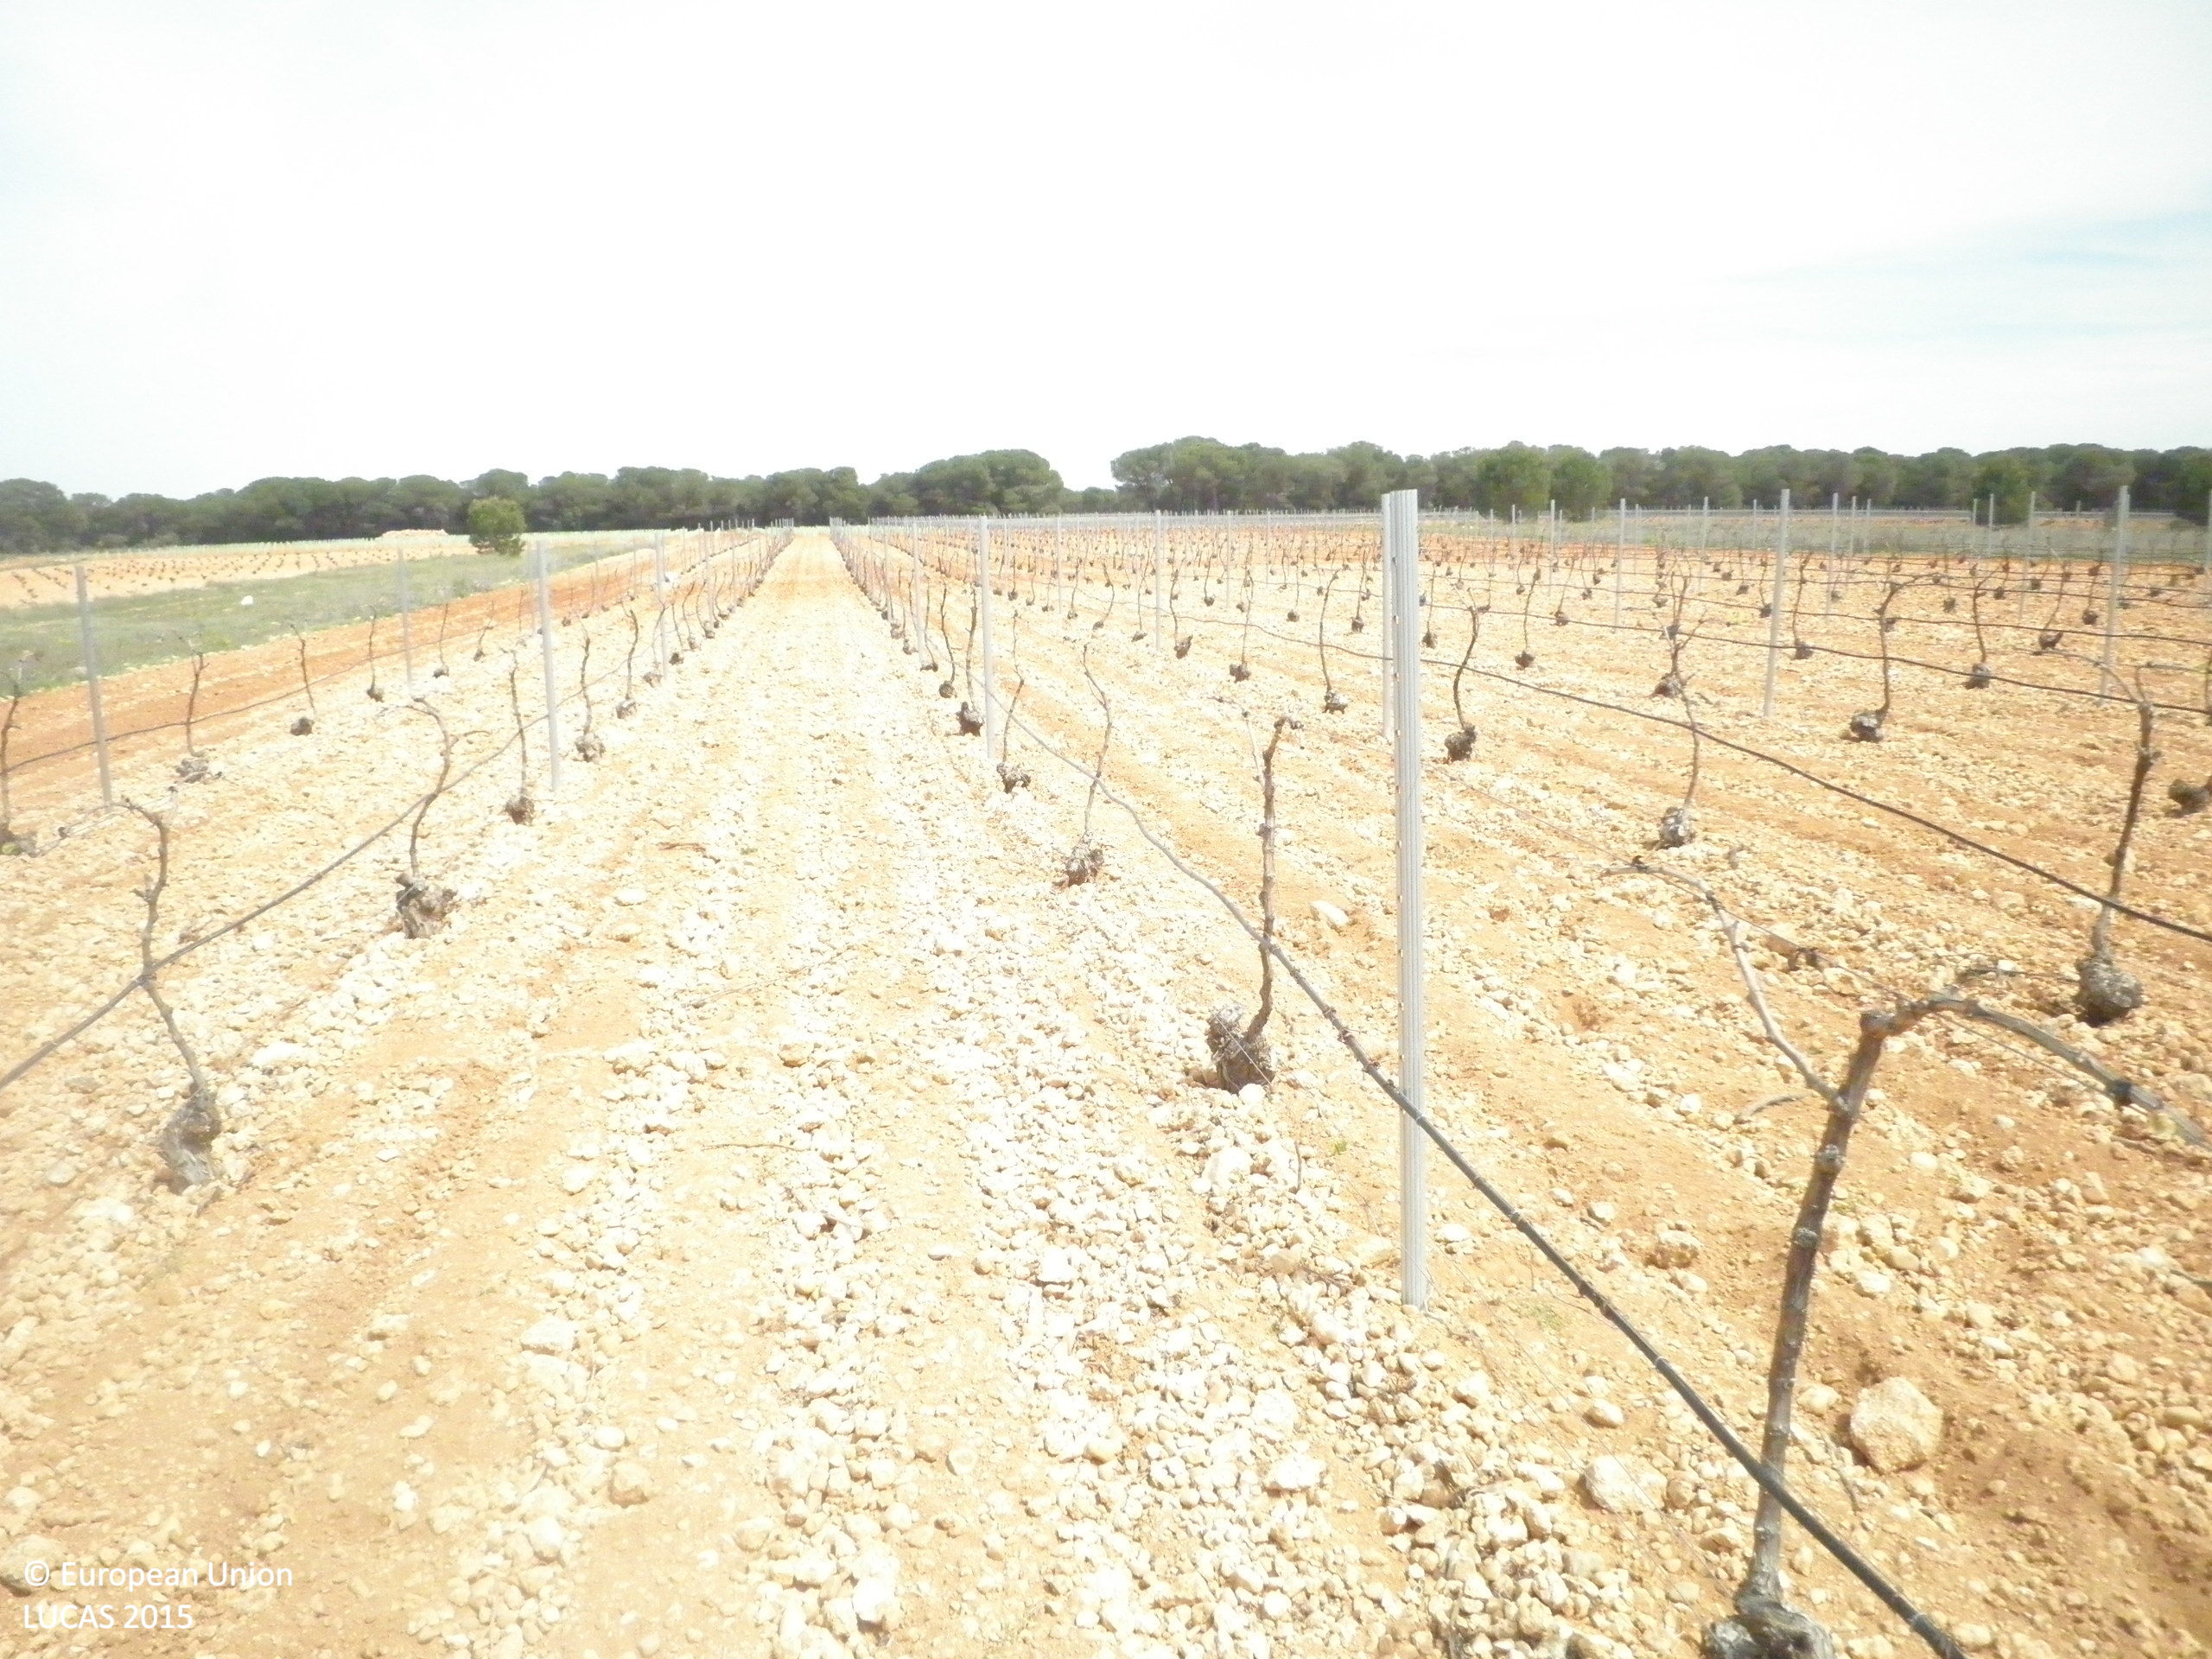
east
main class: Cropland
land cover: Vineyards
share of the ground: < 10 %
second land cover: Other bare soil
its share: > 75 %
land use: Agriculture (excluding fallow land and kitchen gardens)
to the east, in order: Vineyards; Other bare soil; Pine dominated coniferous woodland; Tracks; Pine dominated coniferous woodland; Vineyards
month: April
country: ES
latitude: 39.4101
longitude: -2.6367
